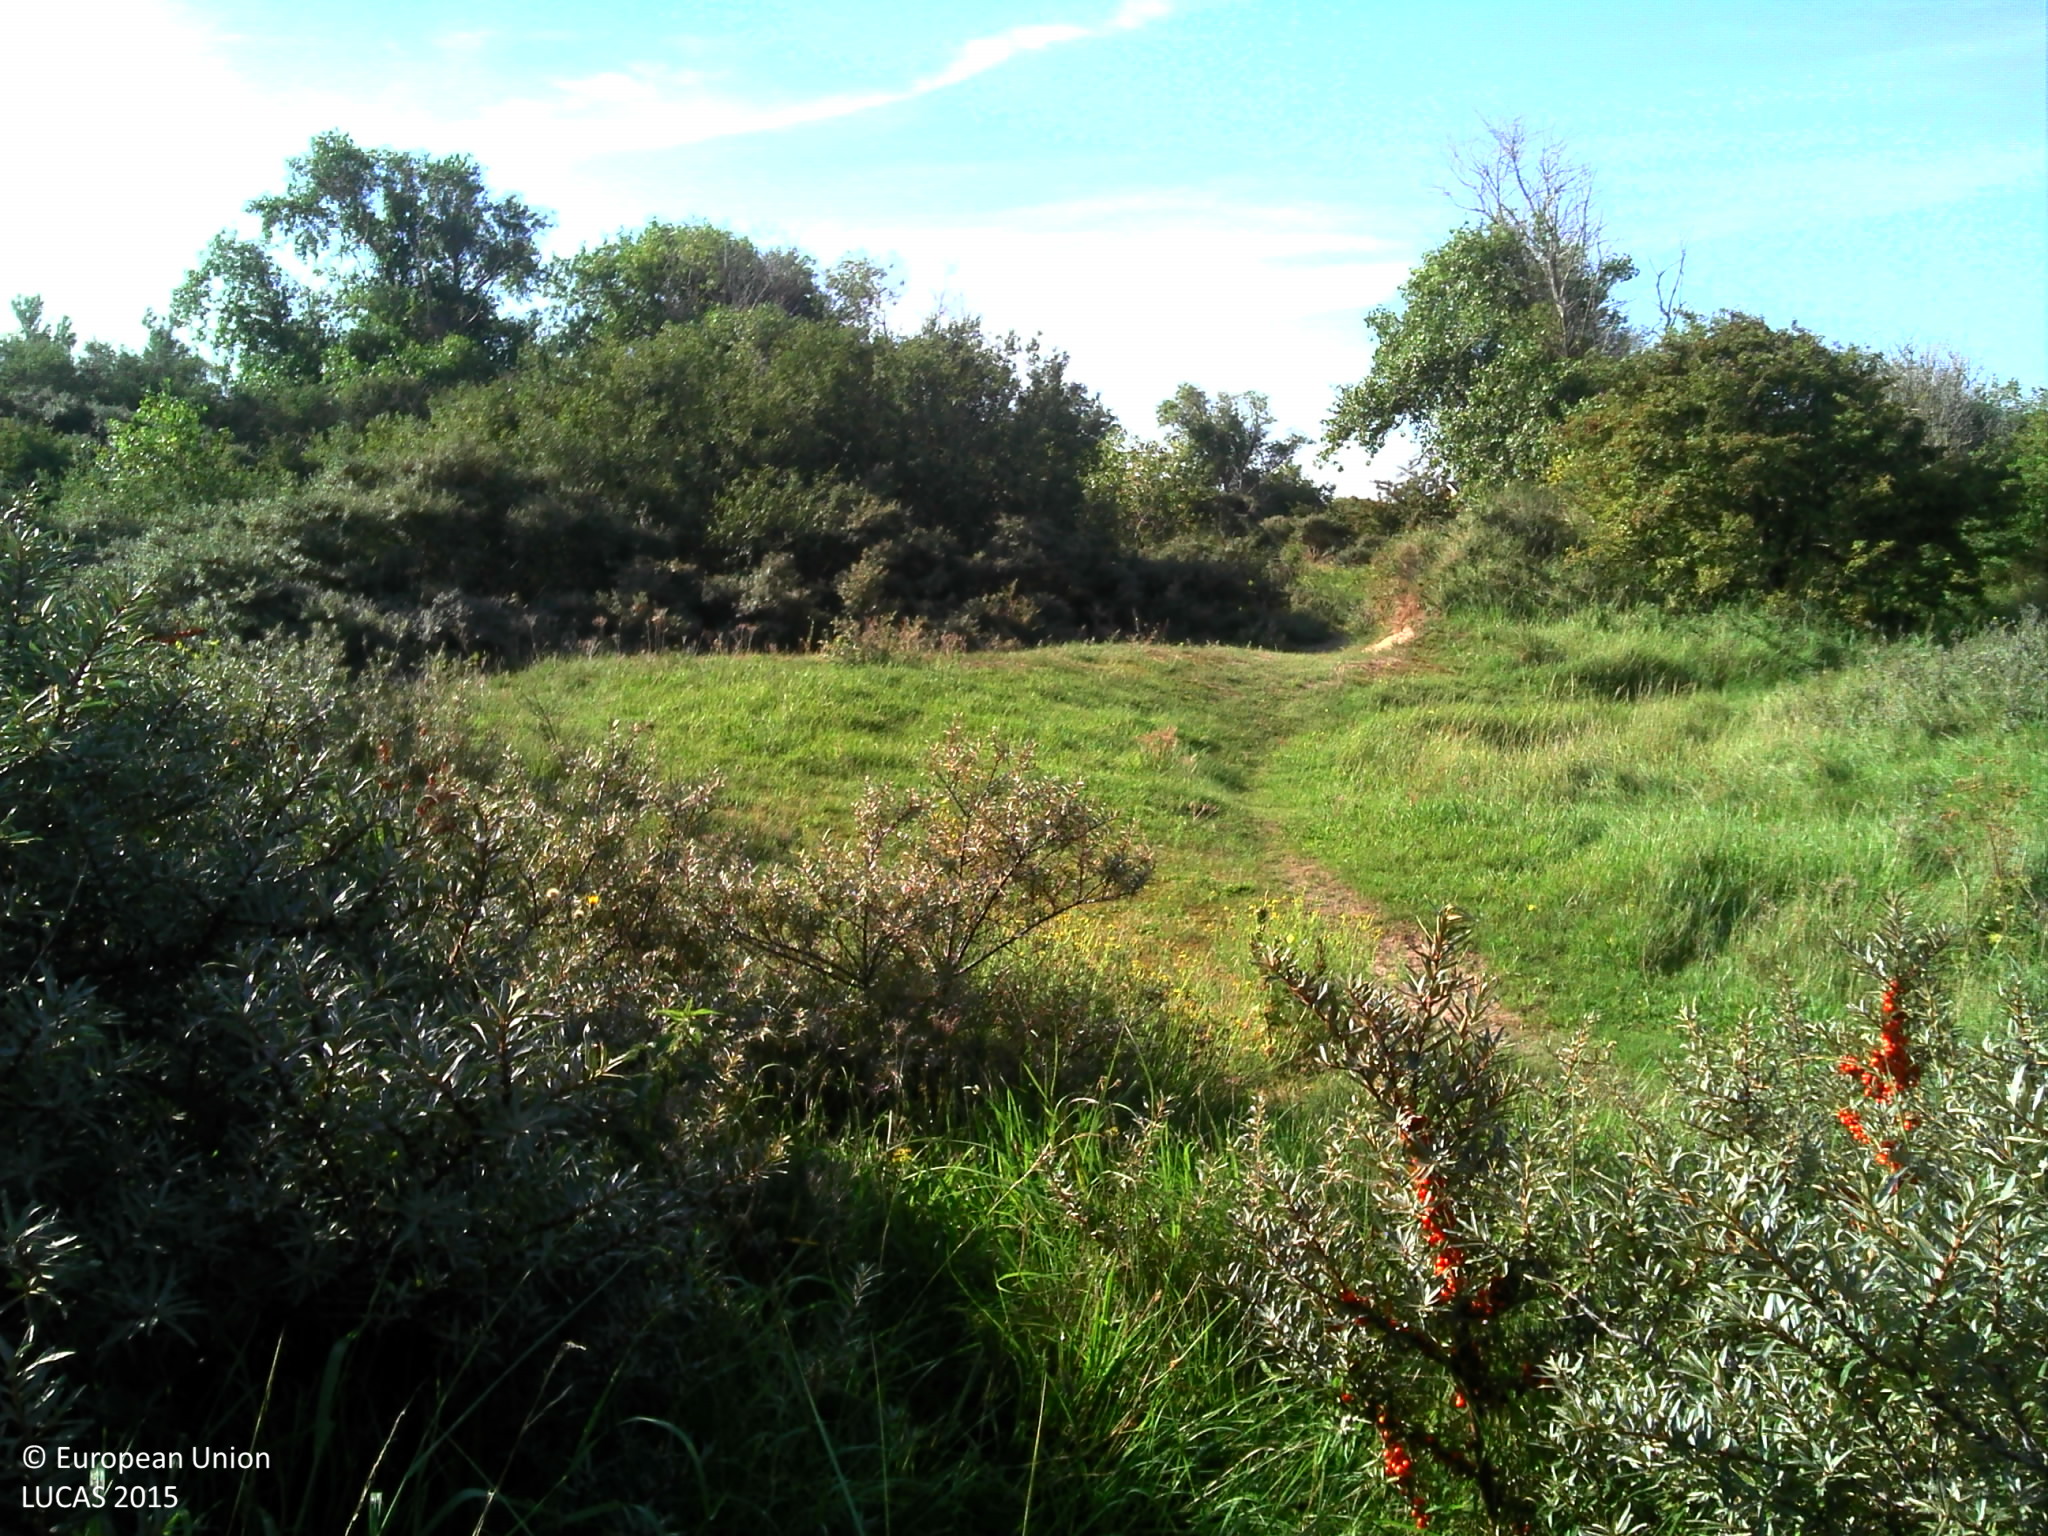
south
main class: Shrubland
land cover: Shrubland without tree cover
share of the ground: > 75 %
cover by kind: shrubs 80 %, herbaceous plants 20 %
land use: Semi-natural and natural areas not in use
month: September
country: BE
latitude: 51.1640
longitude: 2.7670
